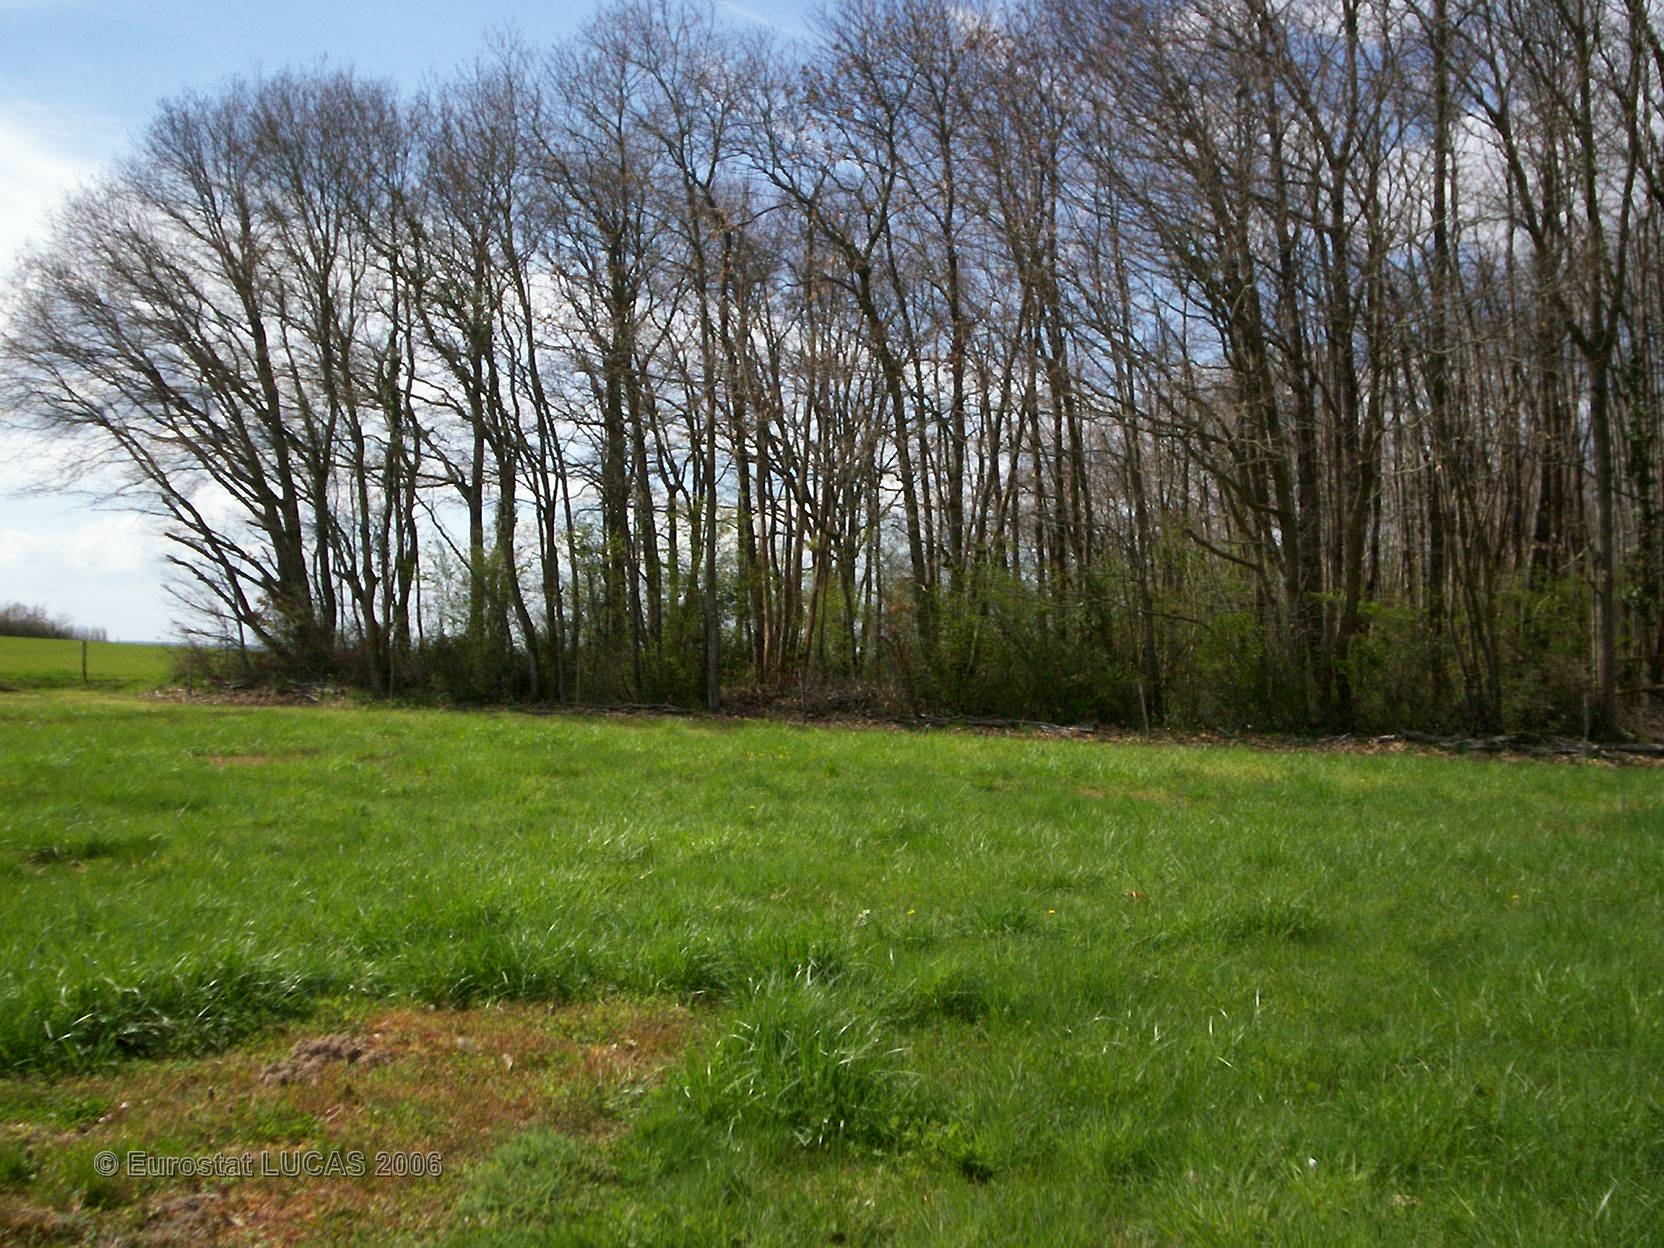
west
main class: Grassland
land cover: Grassland without tree/shrub cover
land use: Agriculture (excluding fallow land and kitchen gardens)
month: April
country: FR
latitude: 47.3676
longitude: -0.3979
